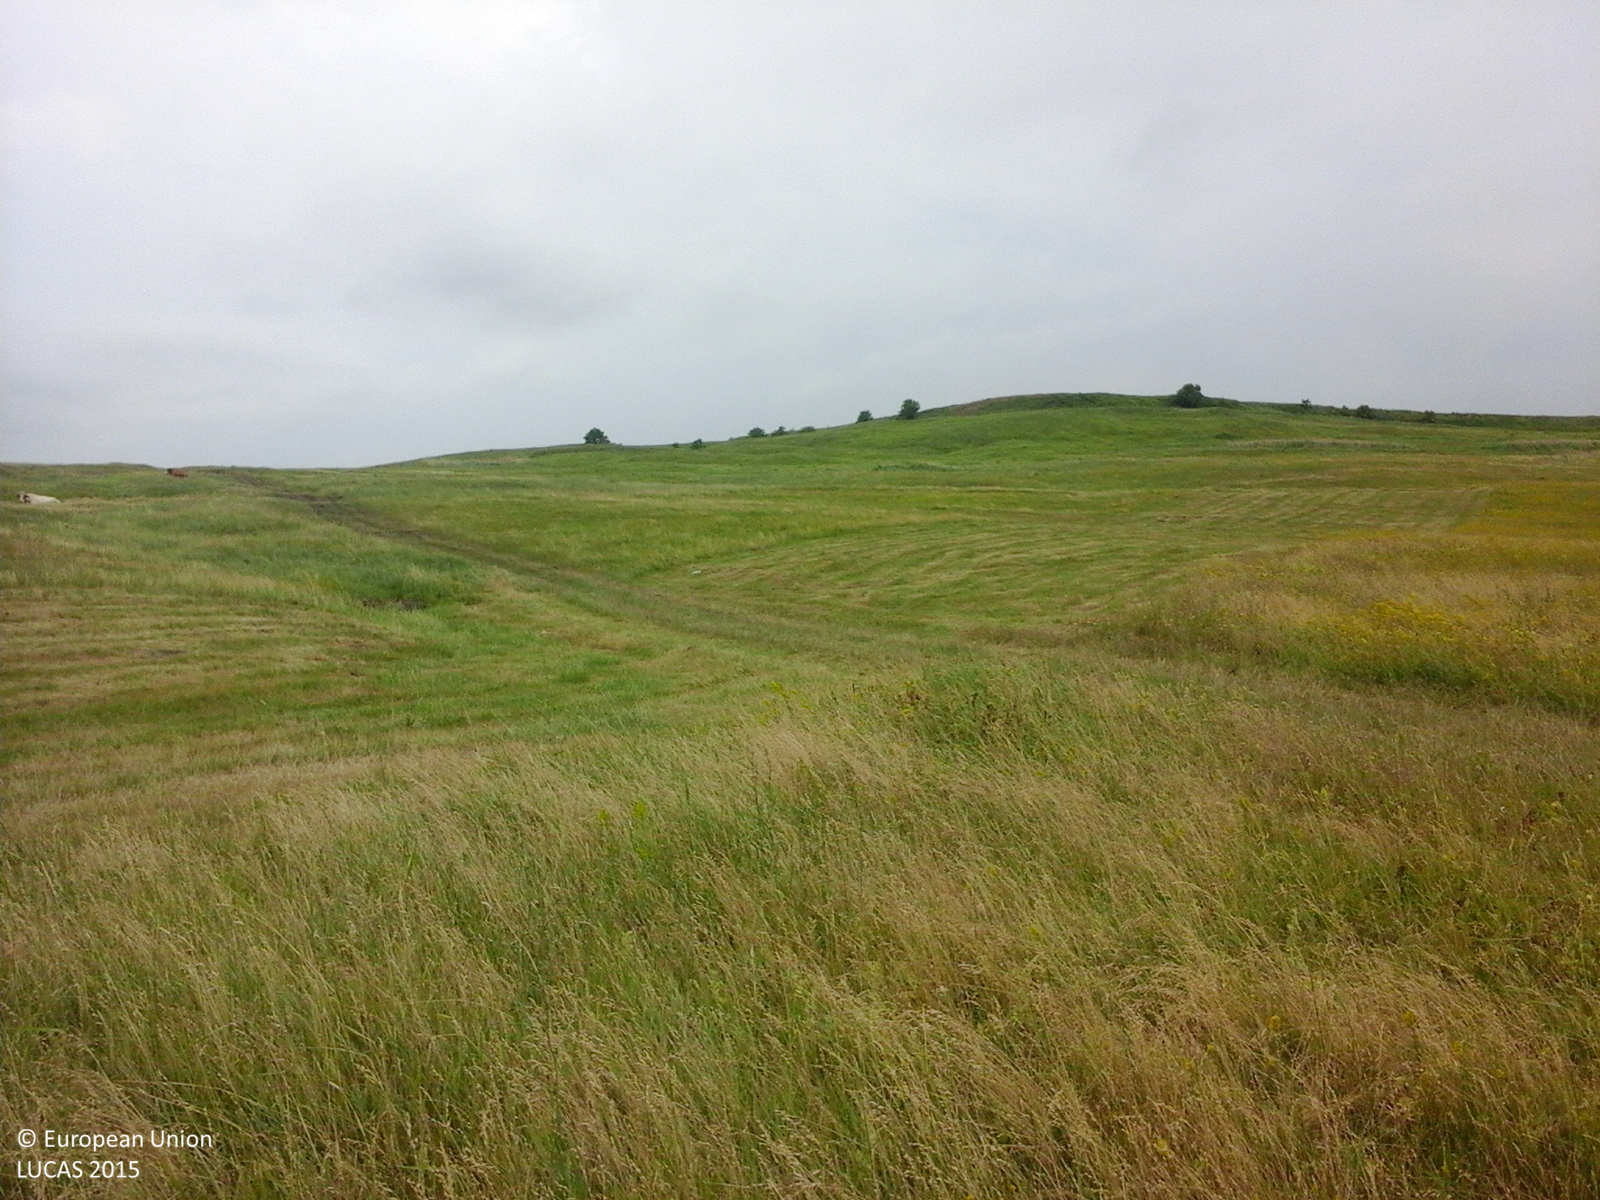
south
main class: Grassland
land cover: Grassland without tree/shrub cover
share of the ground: > 75 %
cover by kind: herbaceous plants 100 %
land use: Agriculture (excluding fallow land and kitchen gardens)
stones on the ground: < 10 %
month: June
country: RO
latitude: 47.8319
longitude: 26.6199
